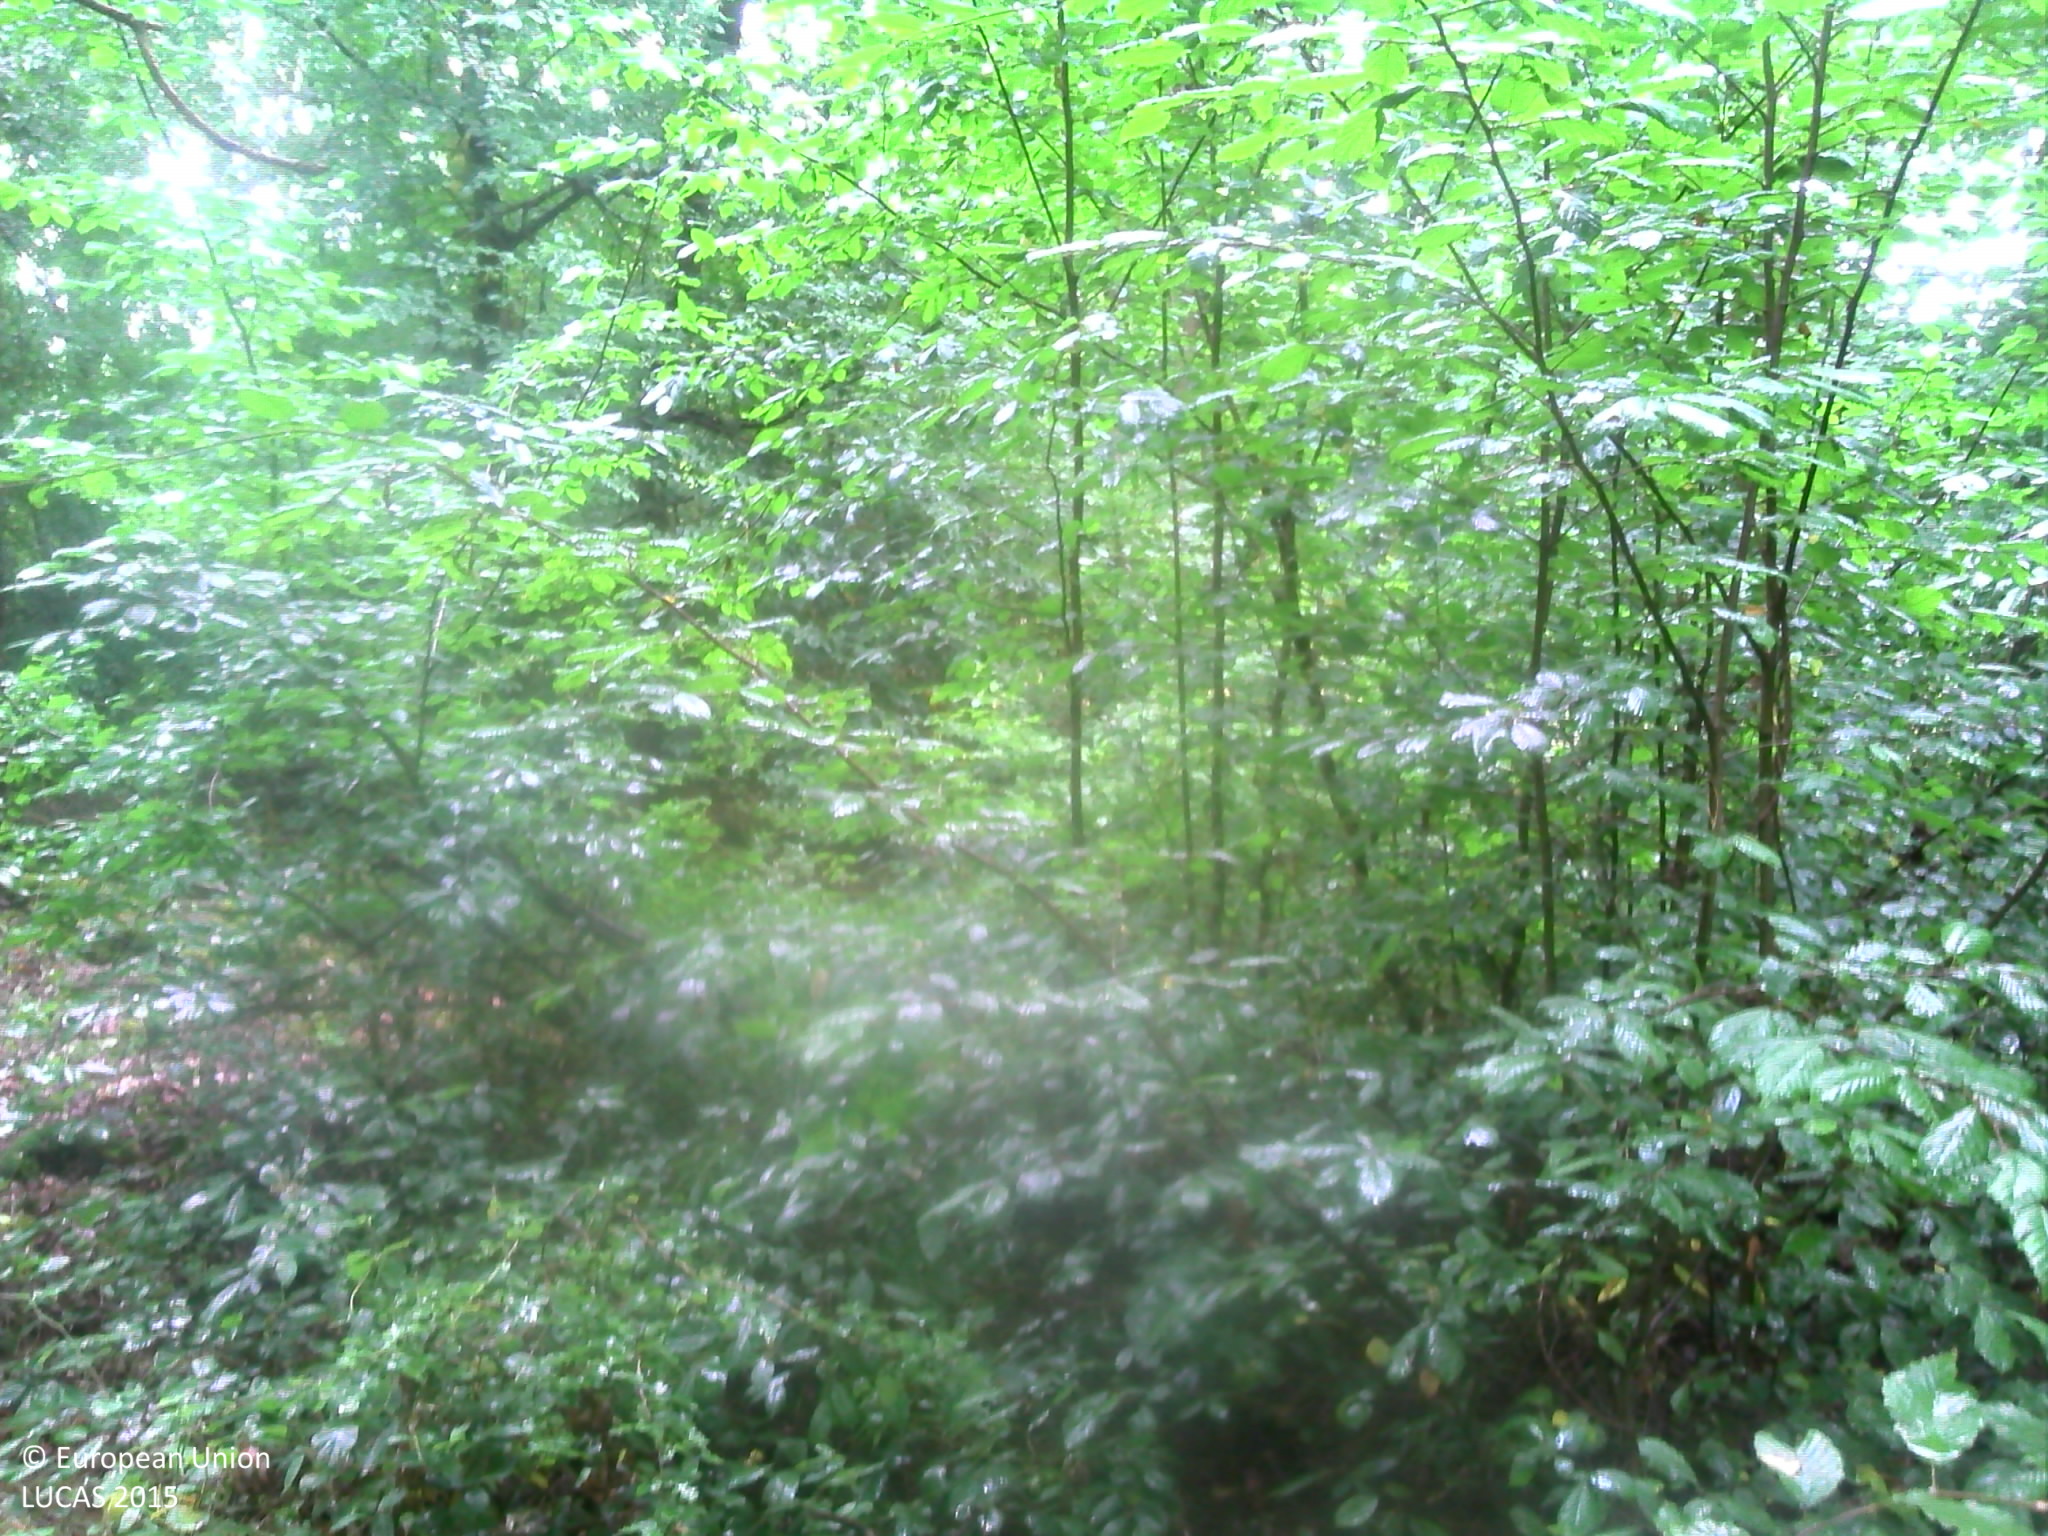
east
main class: Woodland
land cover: Pine dominated mixed woodland
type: hemiboreal forest and nemoral coniferous forest and mixed broadleaved-coniferous forest
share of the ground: > 75 %
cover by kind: coniferous forest trees 60 %, broadleaved forest trees 30 %, shrubs 5 %, herbaceous plants 5 %
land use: Forestry
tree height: > 5 m
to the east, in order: Pine dominated mixed woodland; Tracks; Spontaneously vegetated surfaces; Pine dominated mixed woodland; Spontaneously vegetated surfaces; Broadleaved woodland
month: July
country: BE
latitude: 50.1521
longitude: 4.7203
